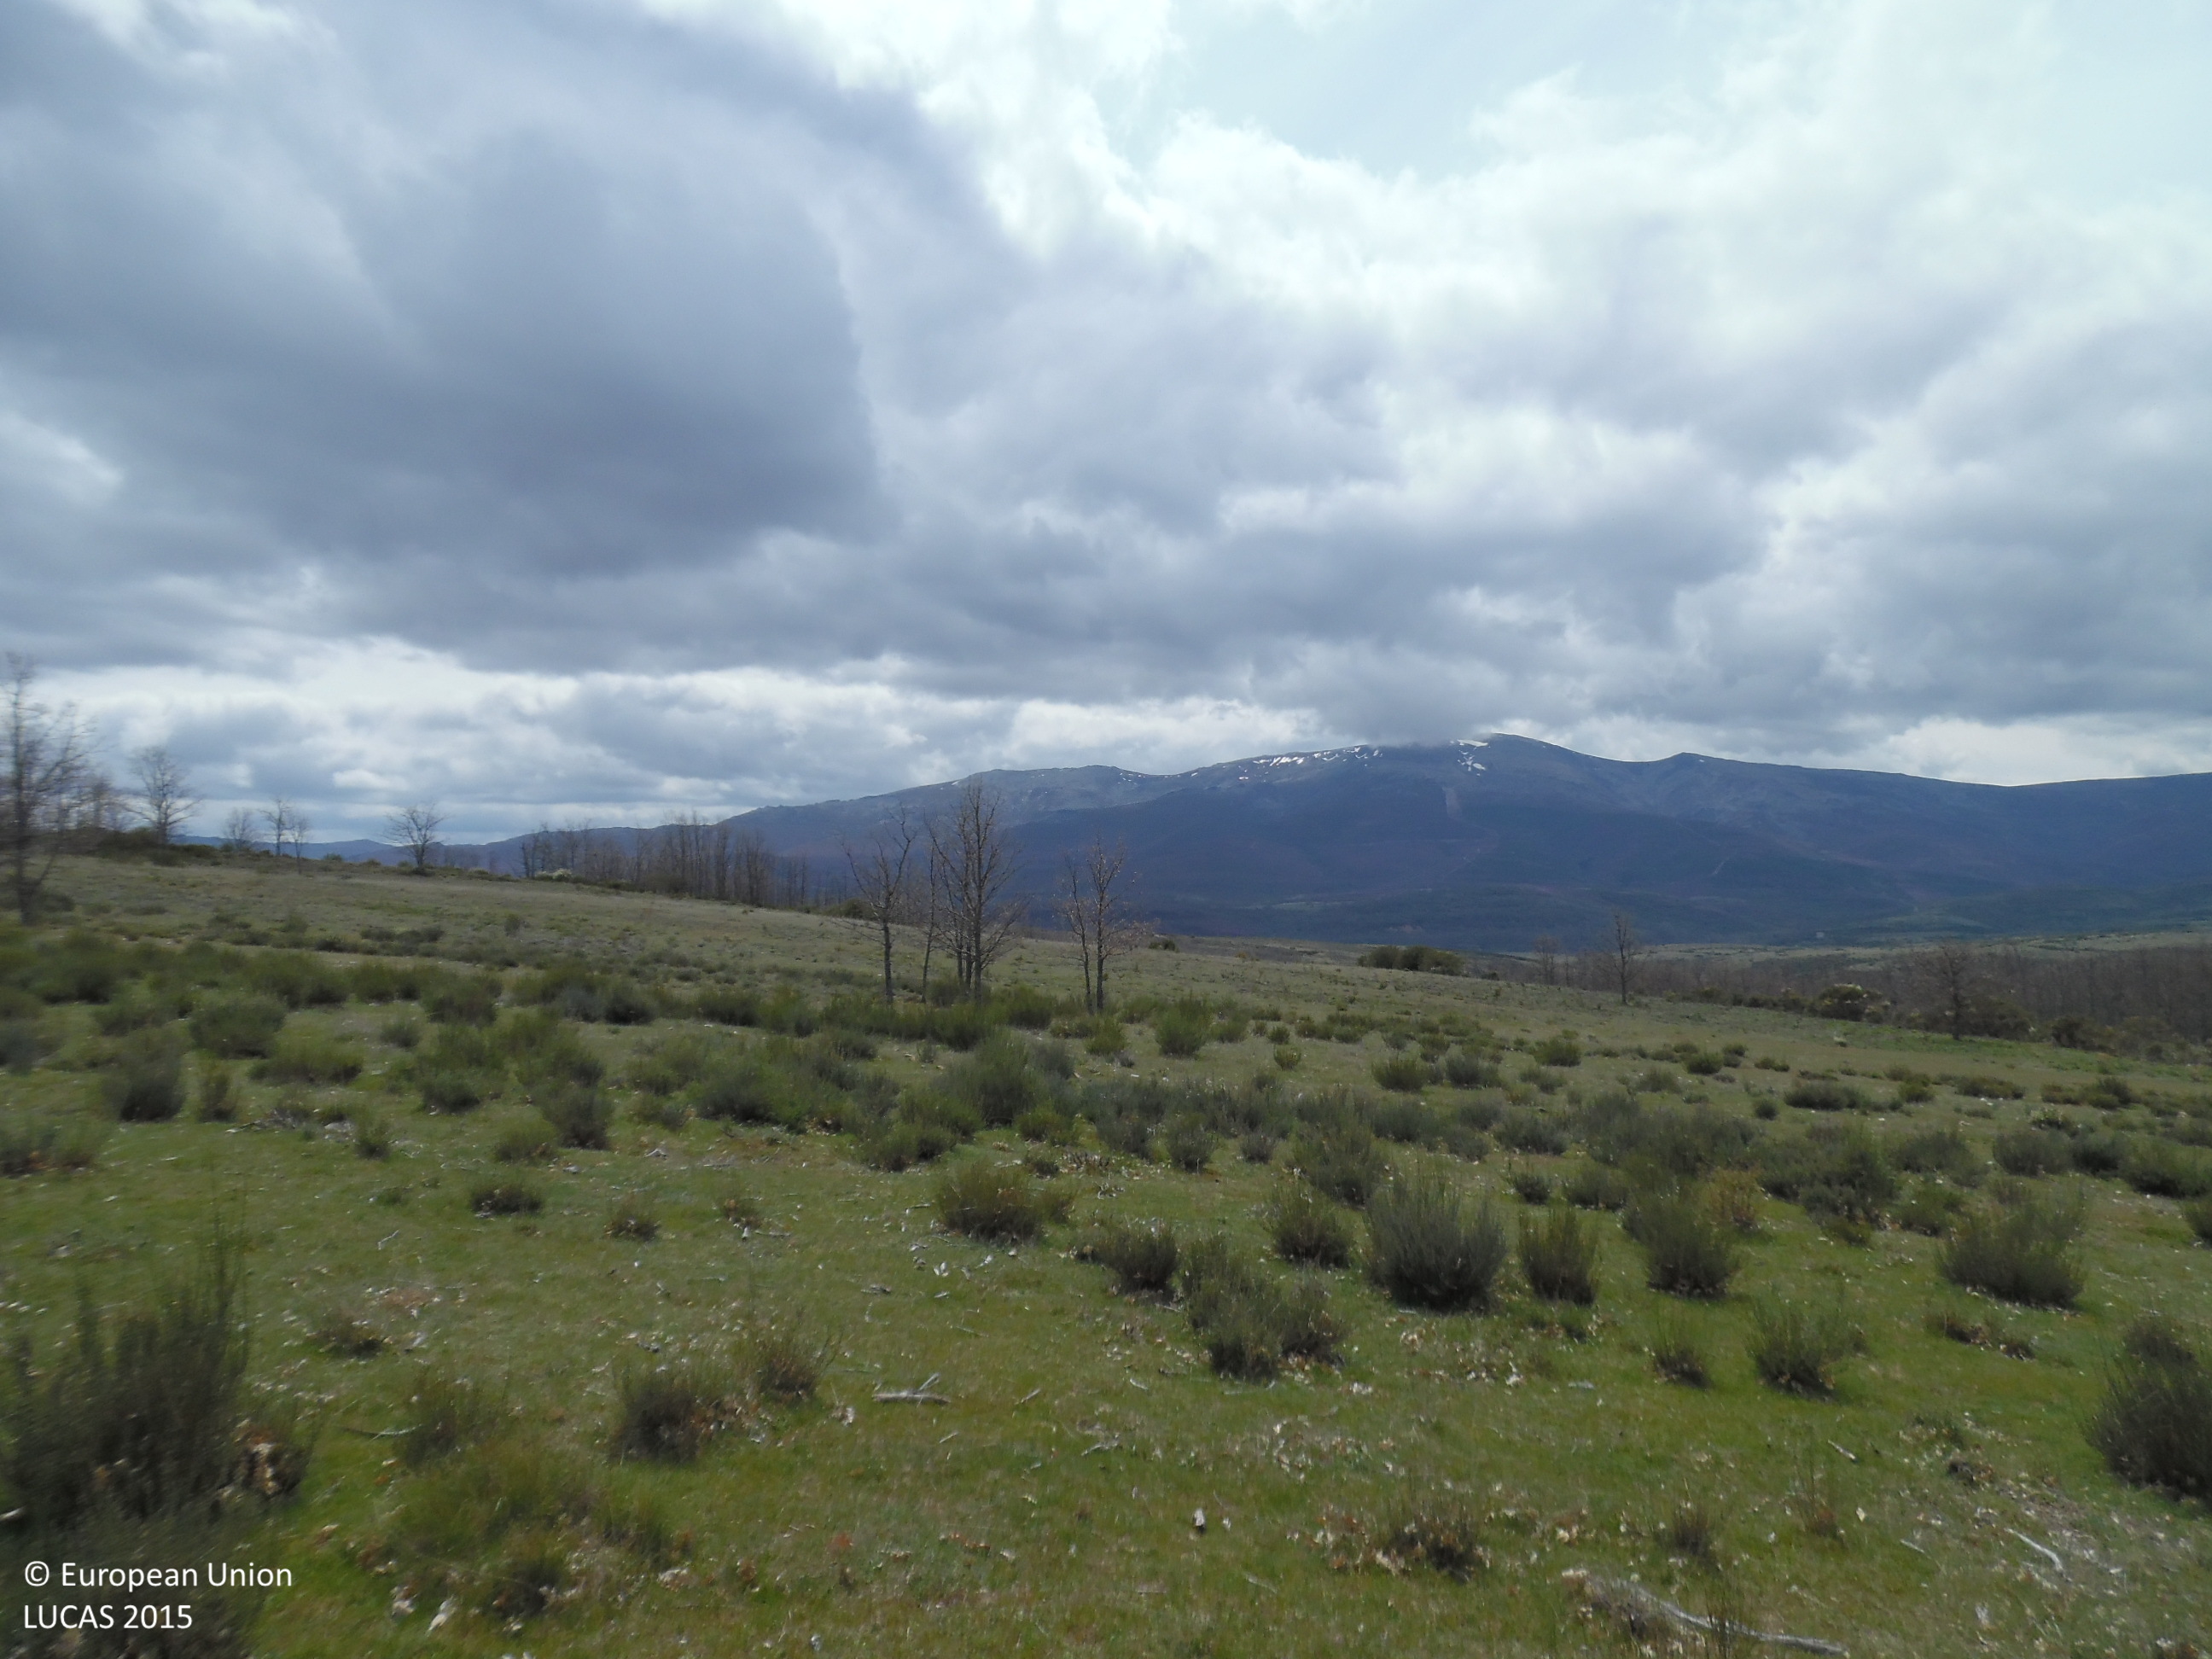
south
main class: Shrubland
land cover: Shrubland with sparse tree cover
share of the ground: 50 - 75 %
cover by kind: shrubs 65 %, herbaceous plants 30 %, broadleaved forest trees 5 %
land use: Abandoned areas
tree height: > 5 m
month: April
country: ES
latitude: 42.4204
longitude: -6.3362
